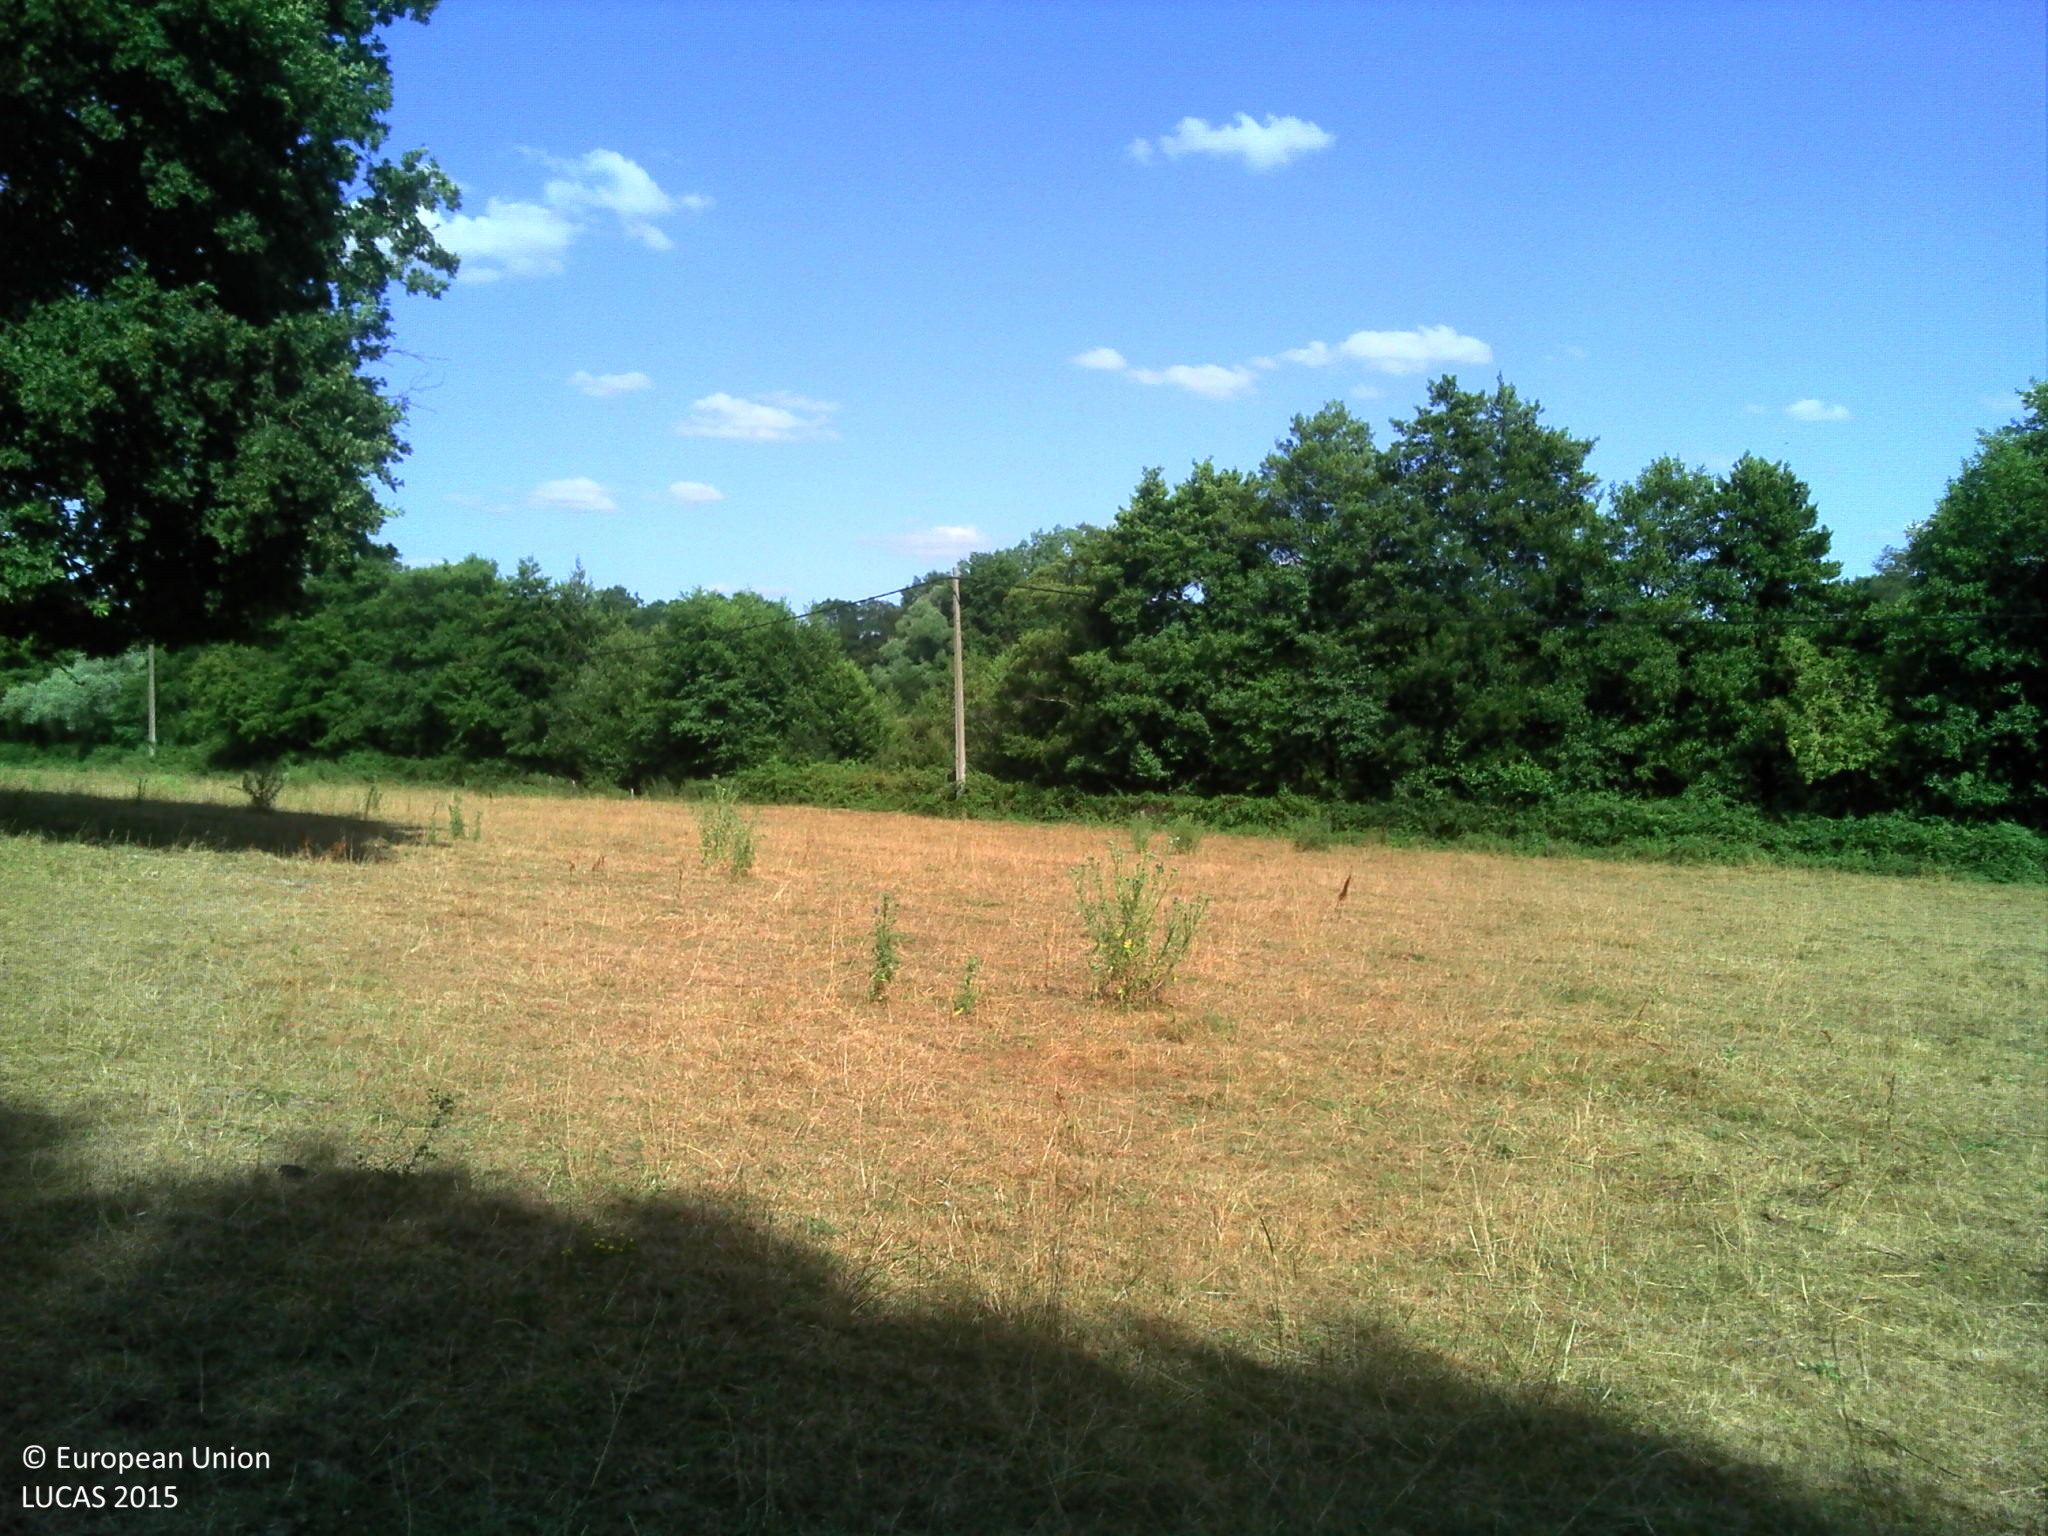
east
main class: Grassland
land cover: Grassland without tree/shrub cover
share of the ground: > 75 %
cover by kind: herbaceous plants 95 %, shrubs 5 %
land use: Agriculture (excluding fallow land and kitchen gardens)
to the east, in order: Grassland without tree/shrub cover; Electric lines; Fences; Abandoned hedges; Rivers and streams; Managed hedges; Grass margins; Ditches and canals; Tracks; Managed hedges; Grassland without tree/shrub cover; Managed hedges; Ditches and canals; Tracks; Managed hedges; Grass margins; Inland fresh water bodies; Shrubland without tree cover
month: July
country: FR
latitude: 46.4817
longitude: 2.9761
